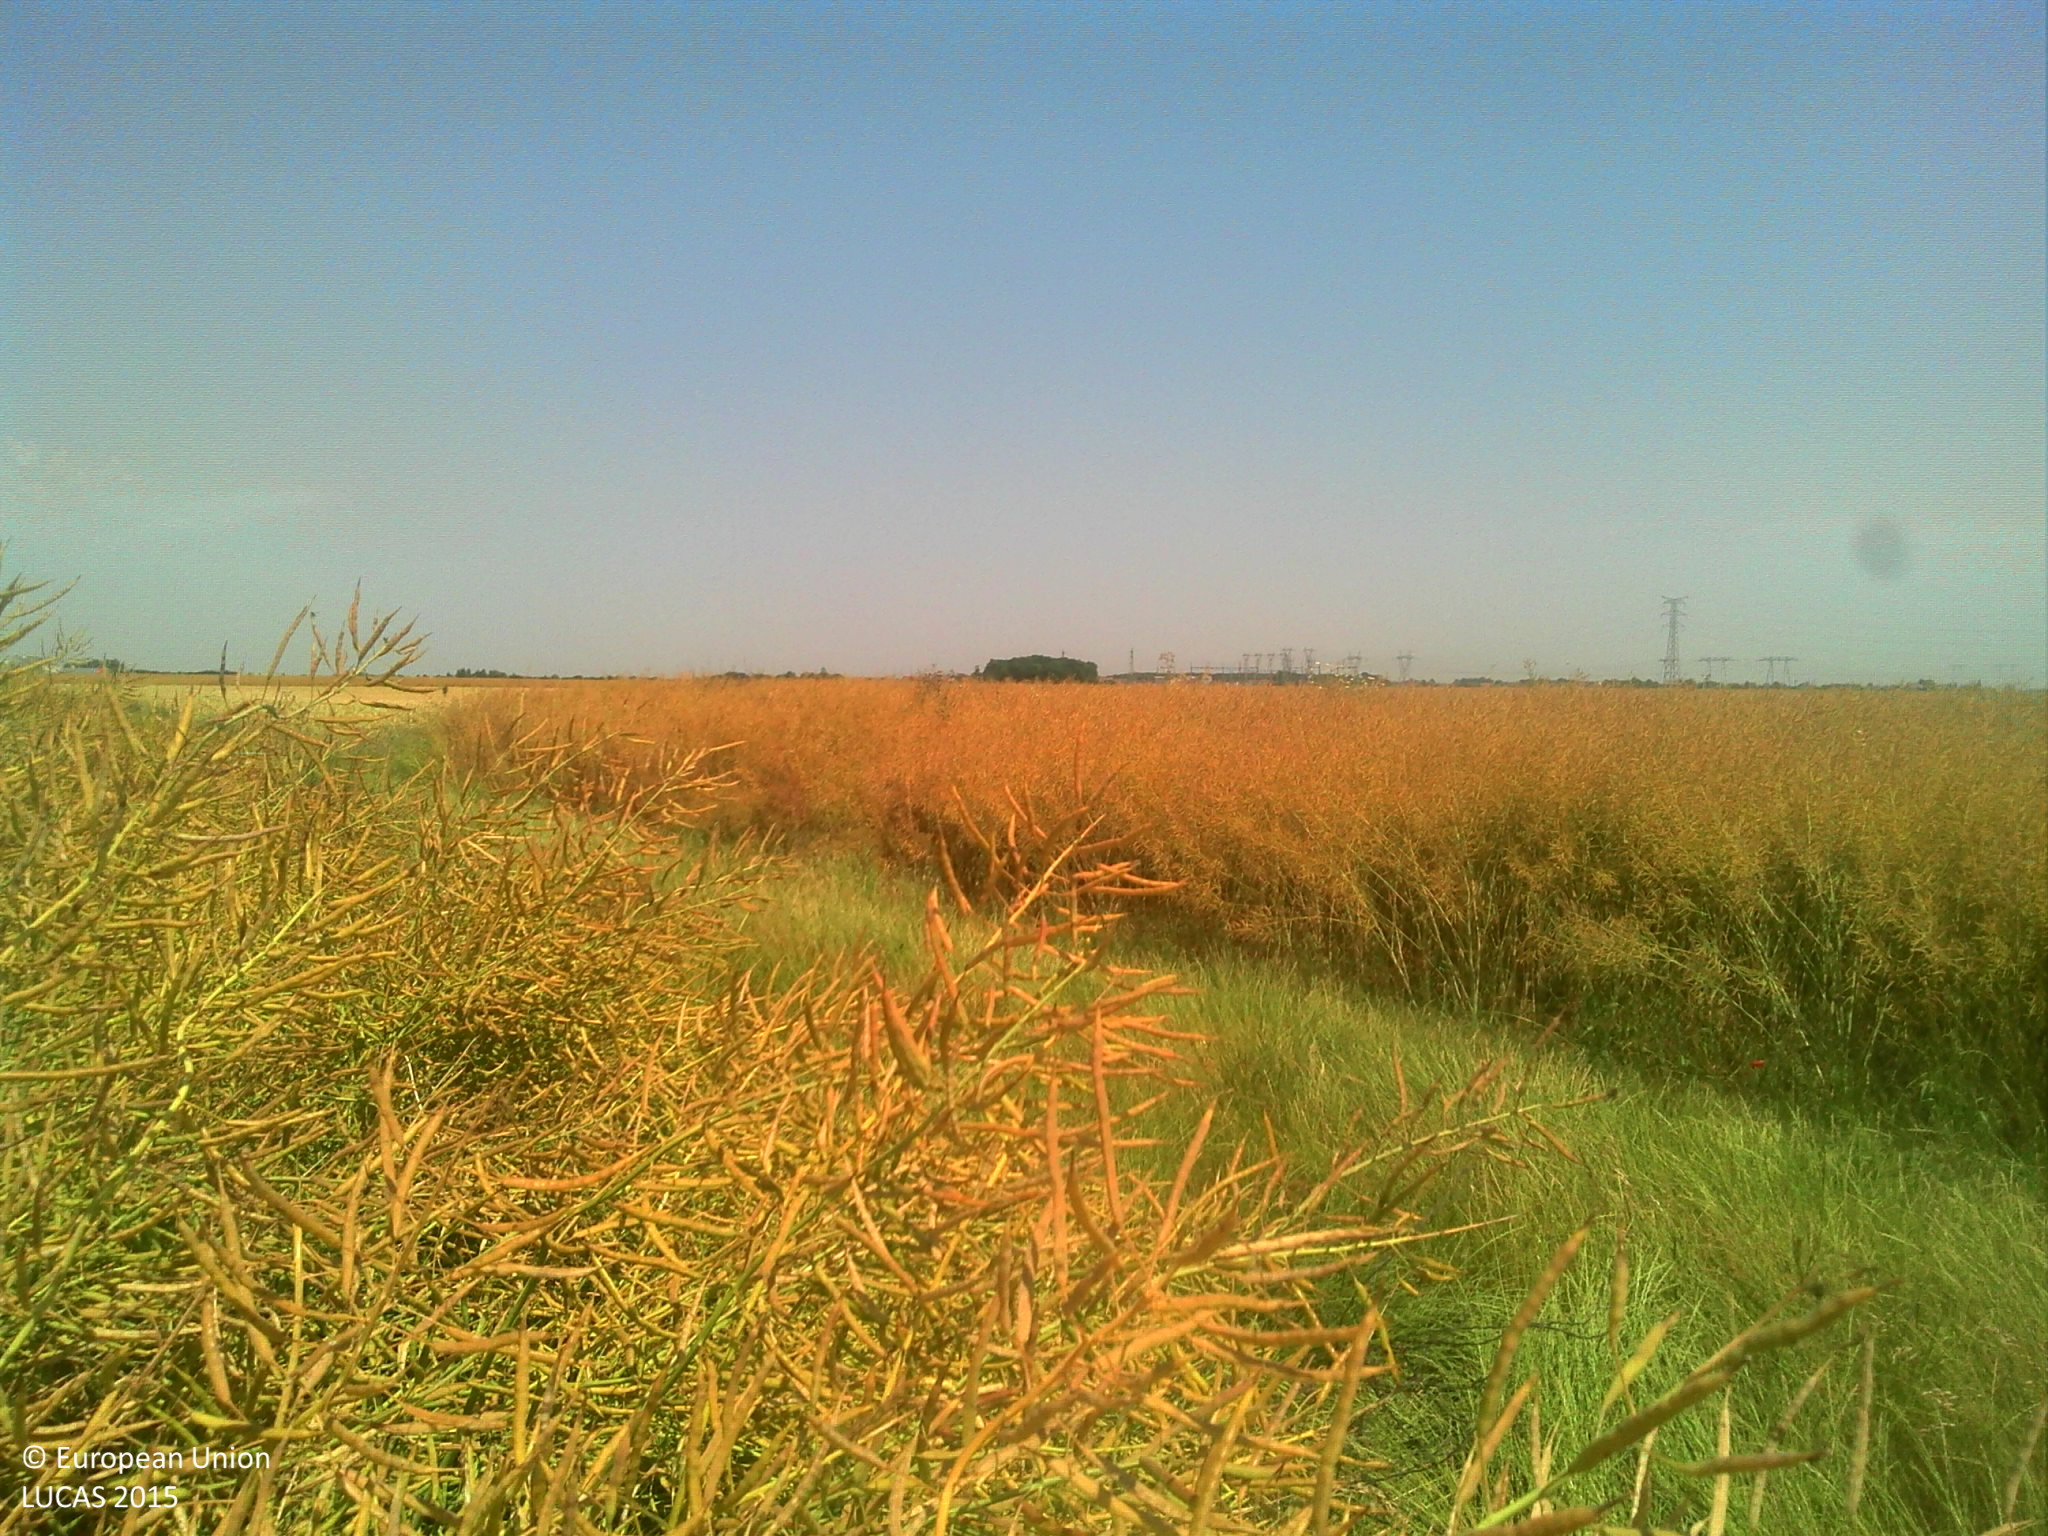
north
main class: Cropland
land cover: Rape and turnip rape
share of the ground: > 75 %
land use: Agriculture (excluding fallow land and kitchen gardens)
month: July
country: FR
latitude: 48.6997
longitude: 1.3812
